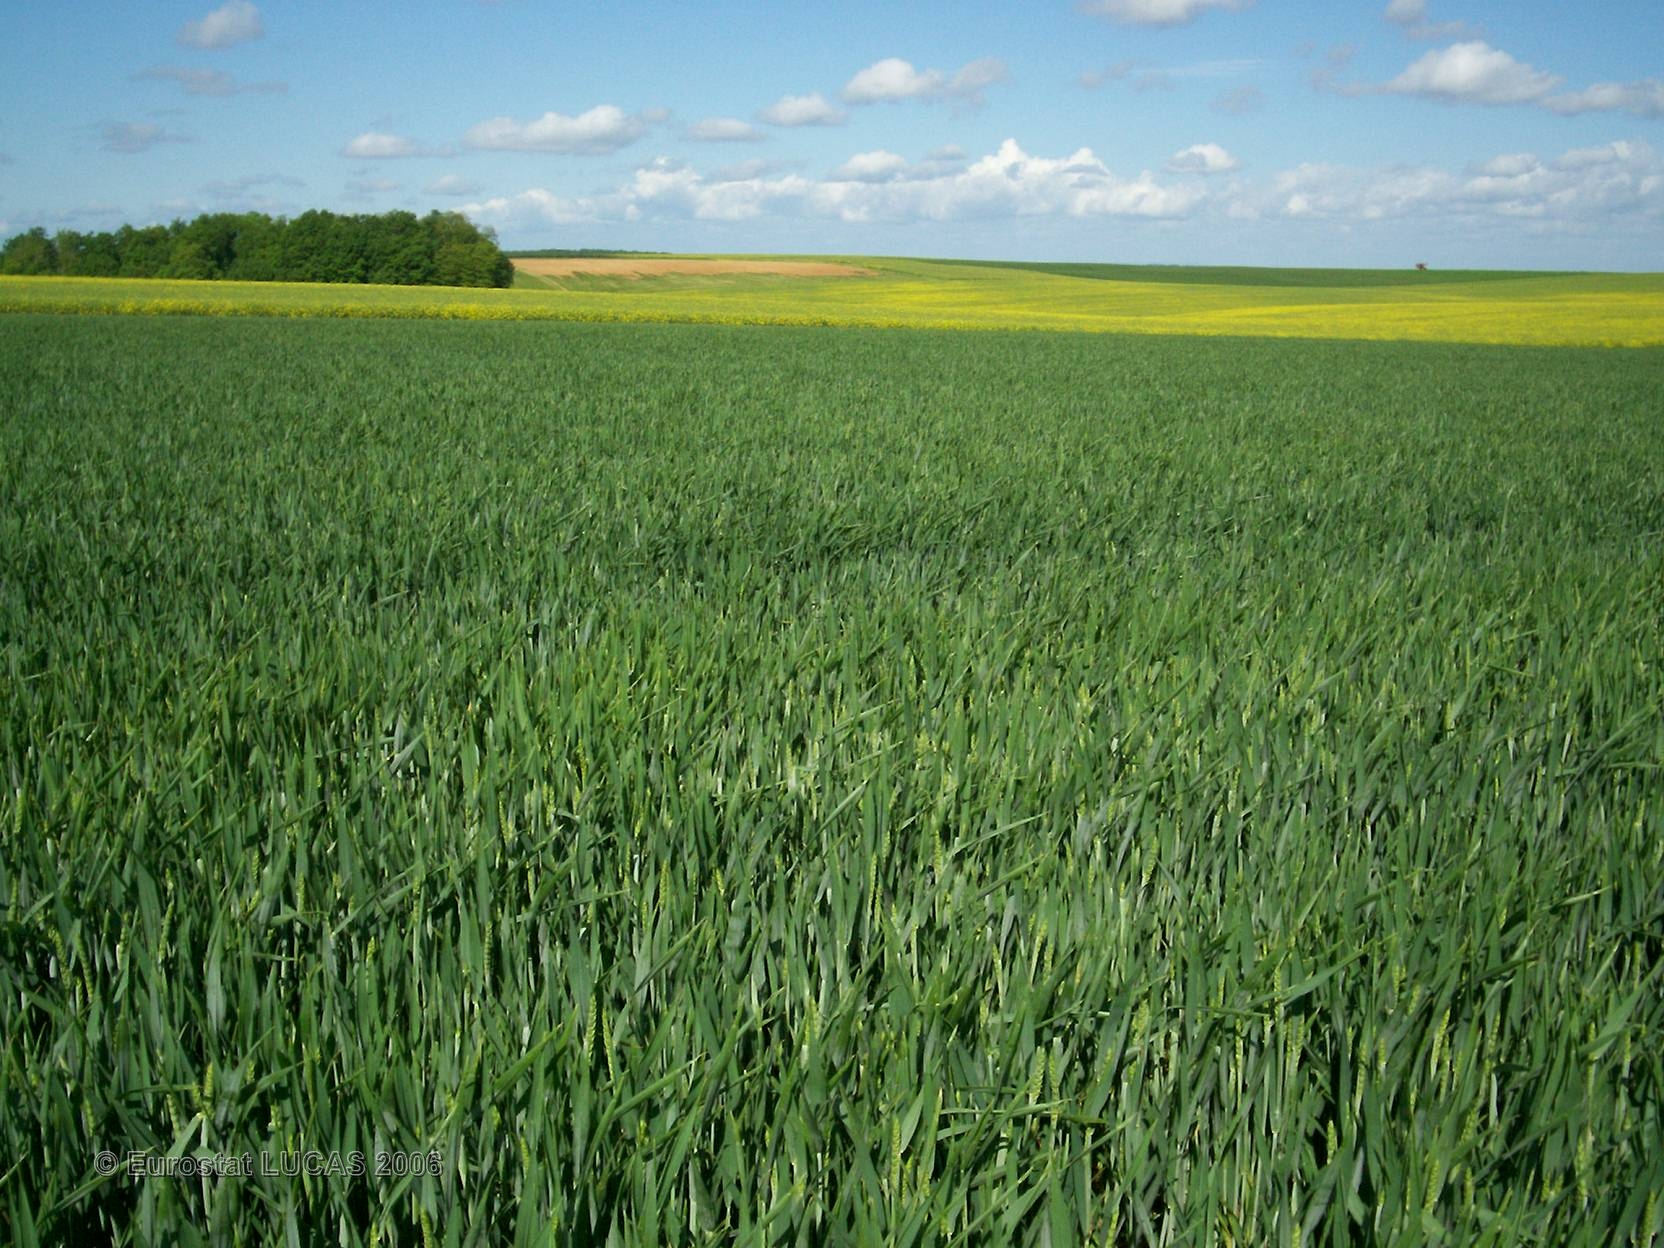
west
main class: Cropland
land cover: Common wheat
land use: Agriculture (excluding fallow land and kitchen gardens)
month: May
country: FR
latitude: 48.1584
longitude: 4.4993
